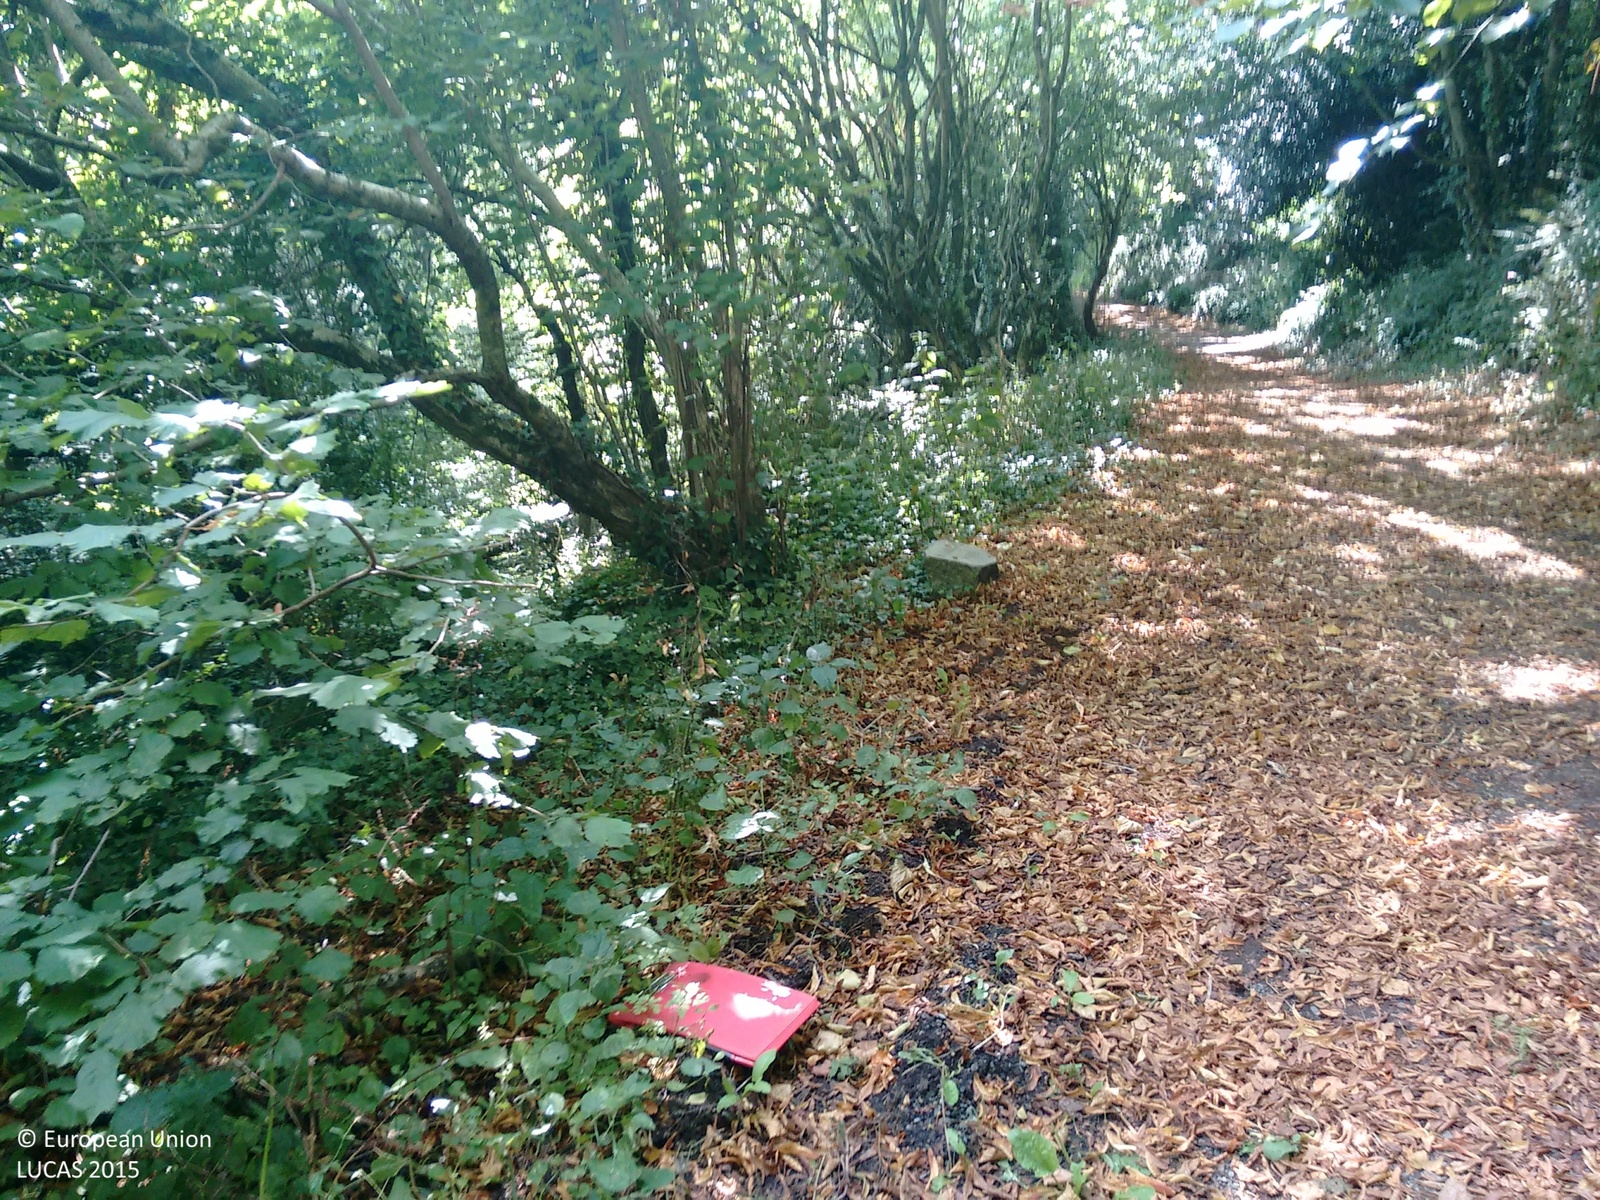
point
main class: Woodland
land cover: Broadleaved woodland
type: mesophytic deciduous forest
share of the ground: > 75 %
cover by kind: broadleaved forest trees 100 %
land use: Semi-natural and natural areas not in use
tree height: > 5 m
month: September
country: GB
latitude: 50.9580
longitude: -4.1491
